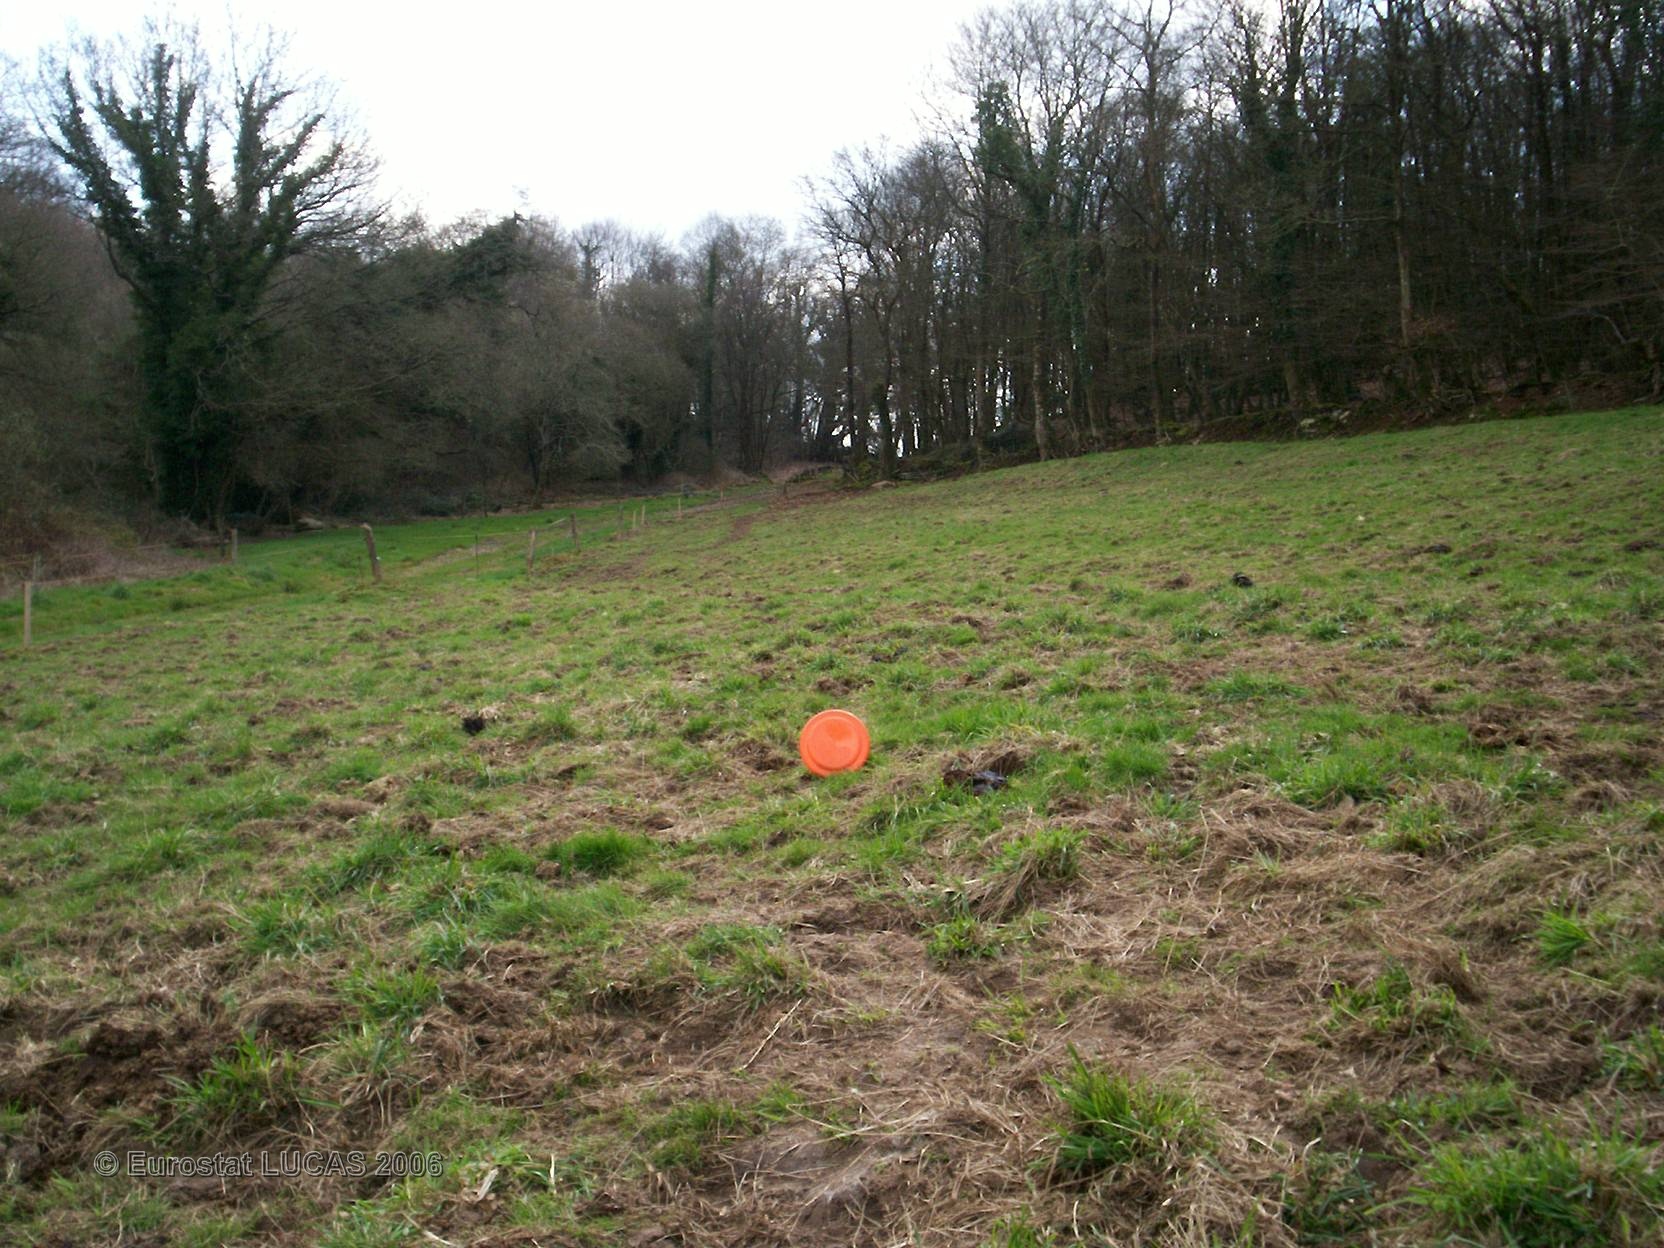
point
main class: Grassland
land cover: Grassland without tree/shrub cover
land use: Agriculture (excluding fallow land and kitchen gardens)
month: April
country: FR
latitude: 48.0590
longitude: -3.5357
